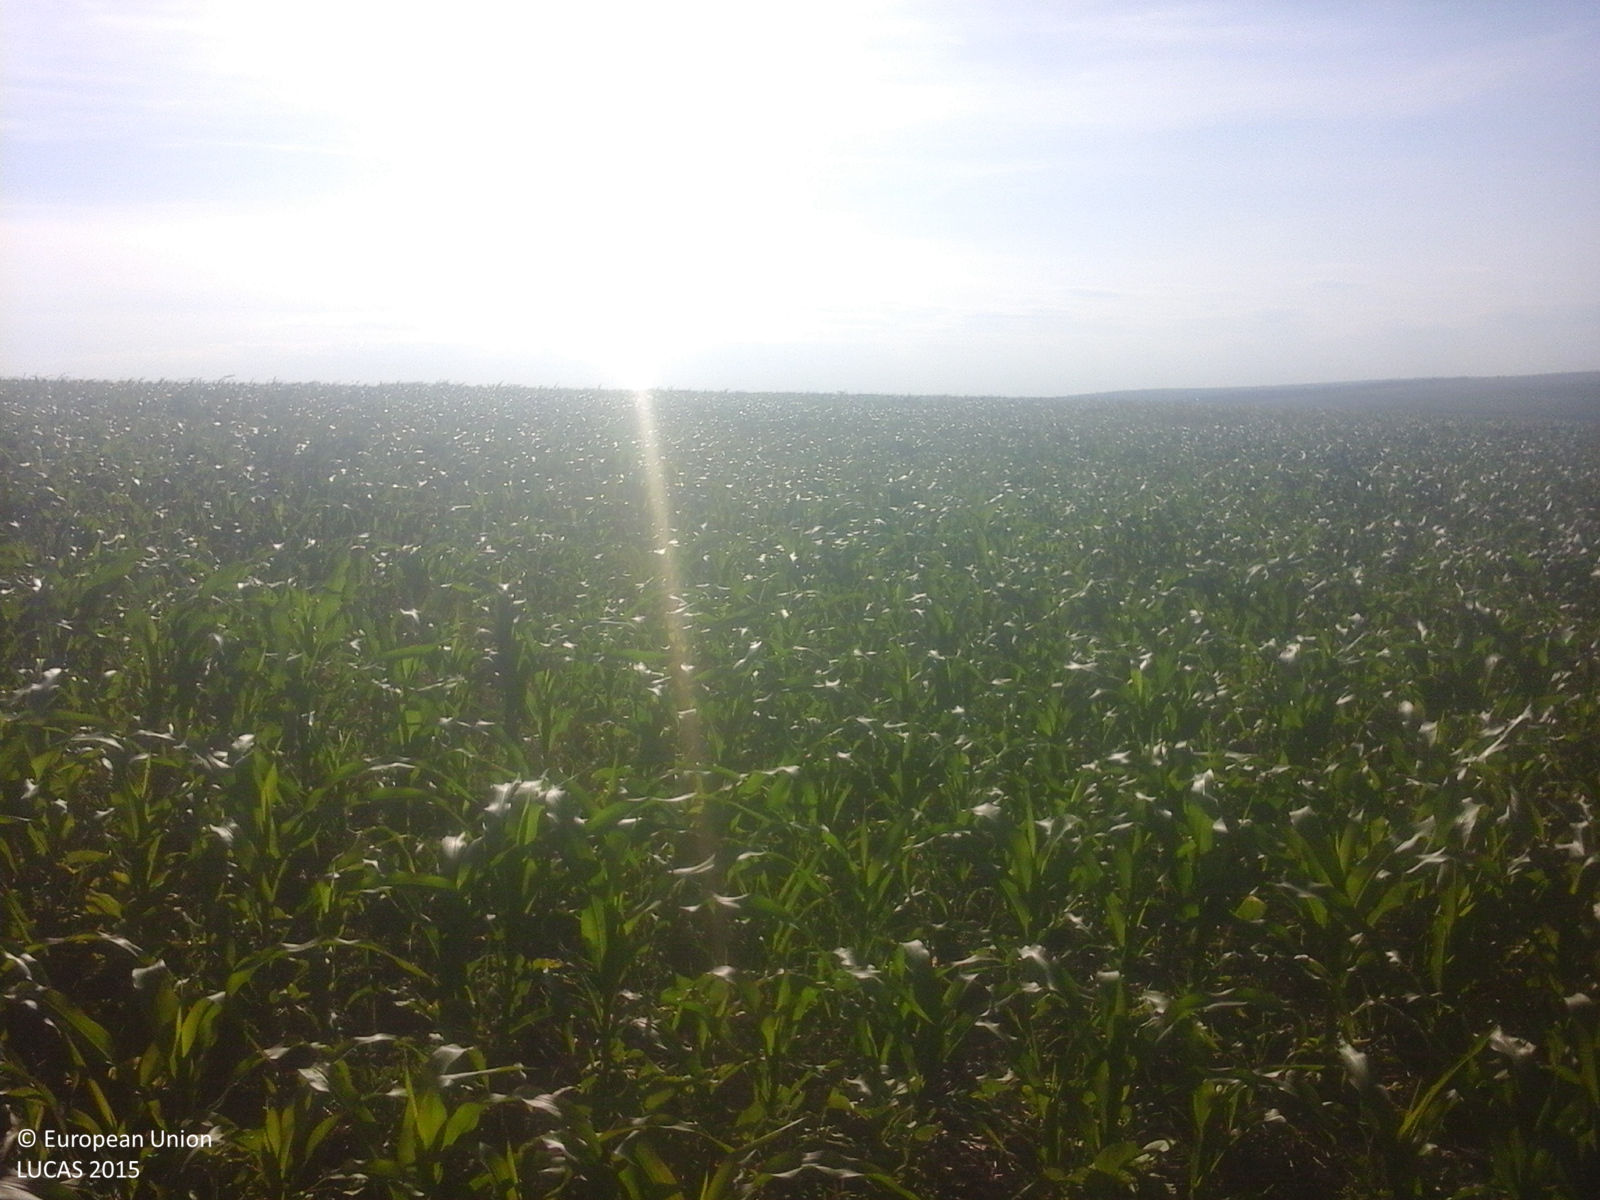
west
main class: Cropland
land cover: Maize
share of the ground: 50 - 75 %
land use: Agriculture (excluding fallow land and kitchen gardens)
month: June
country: RO
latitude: 47.9187
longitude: 27.0071
